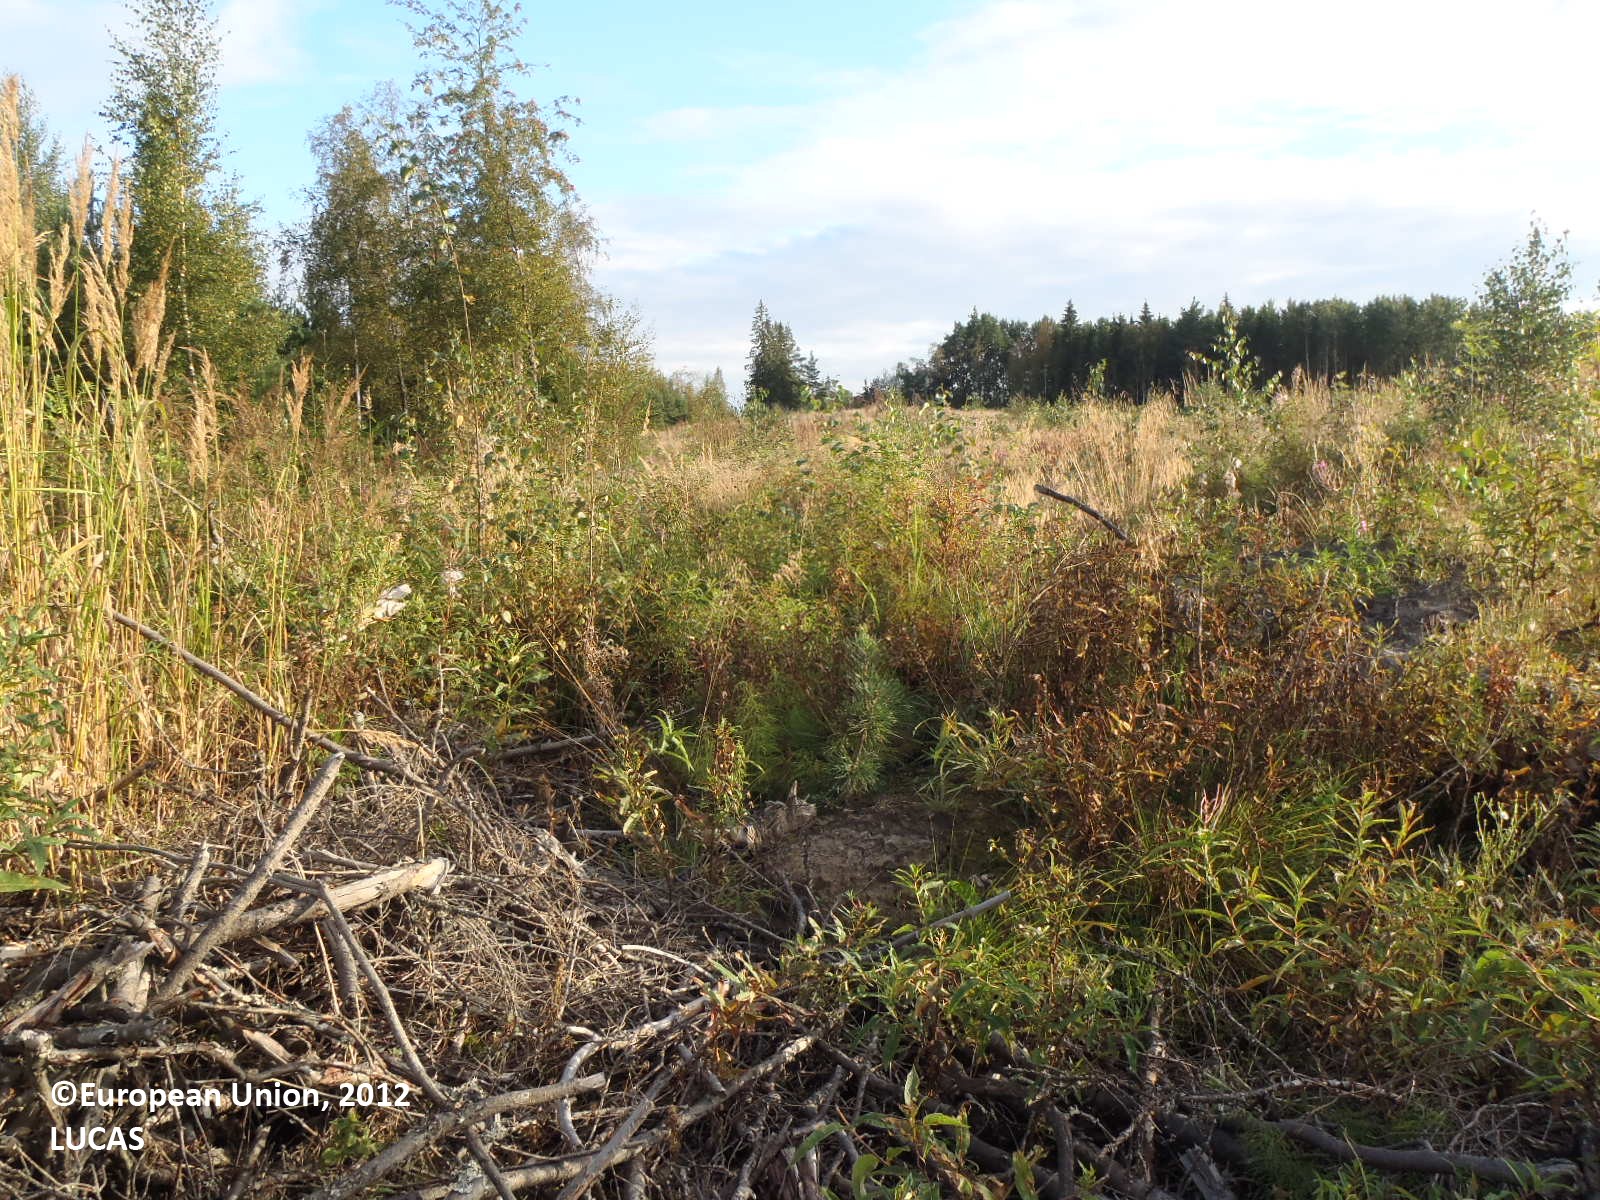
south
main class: Woodland
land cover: Broadleaved woodland
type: boreal forest
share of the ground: 10 - 25 %
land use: Forestry
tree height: < 5 m
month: August
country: FI
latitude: 60.6137
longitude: 22.4370
